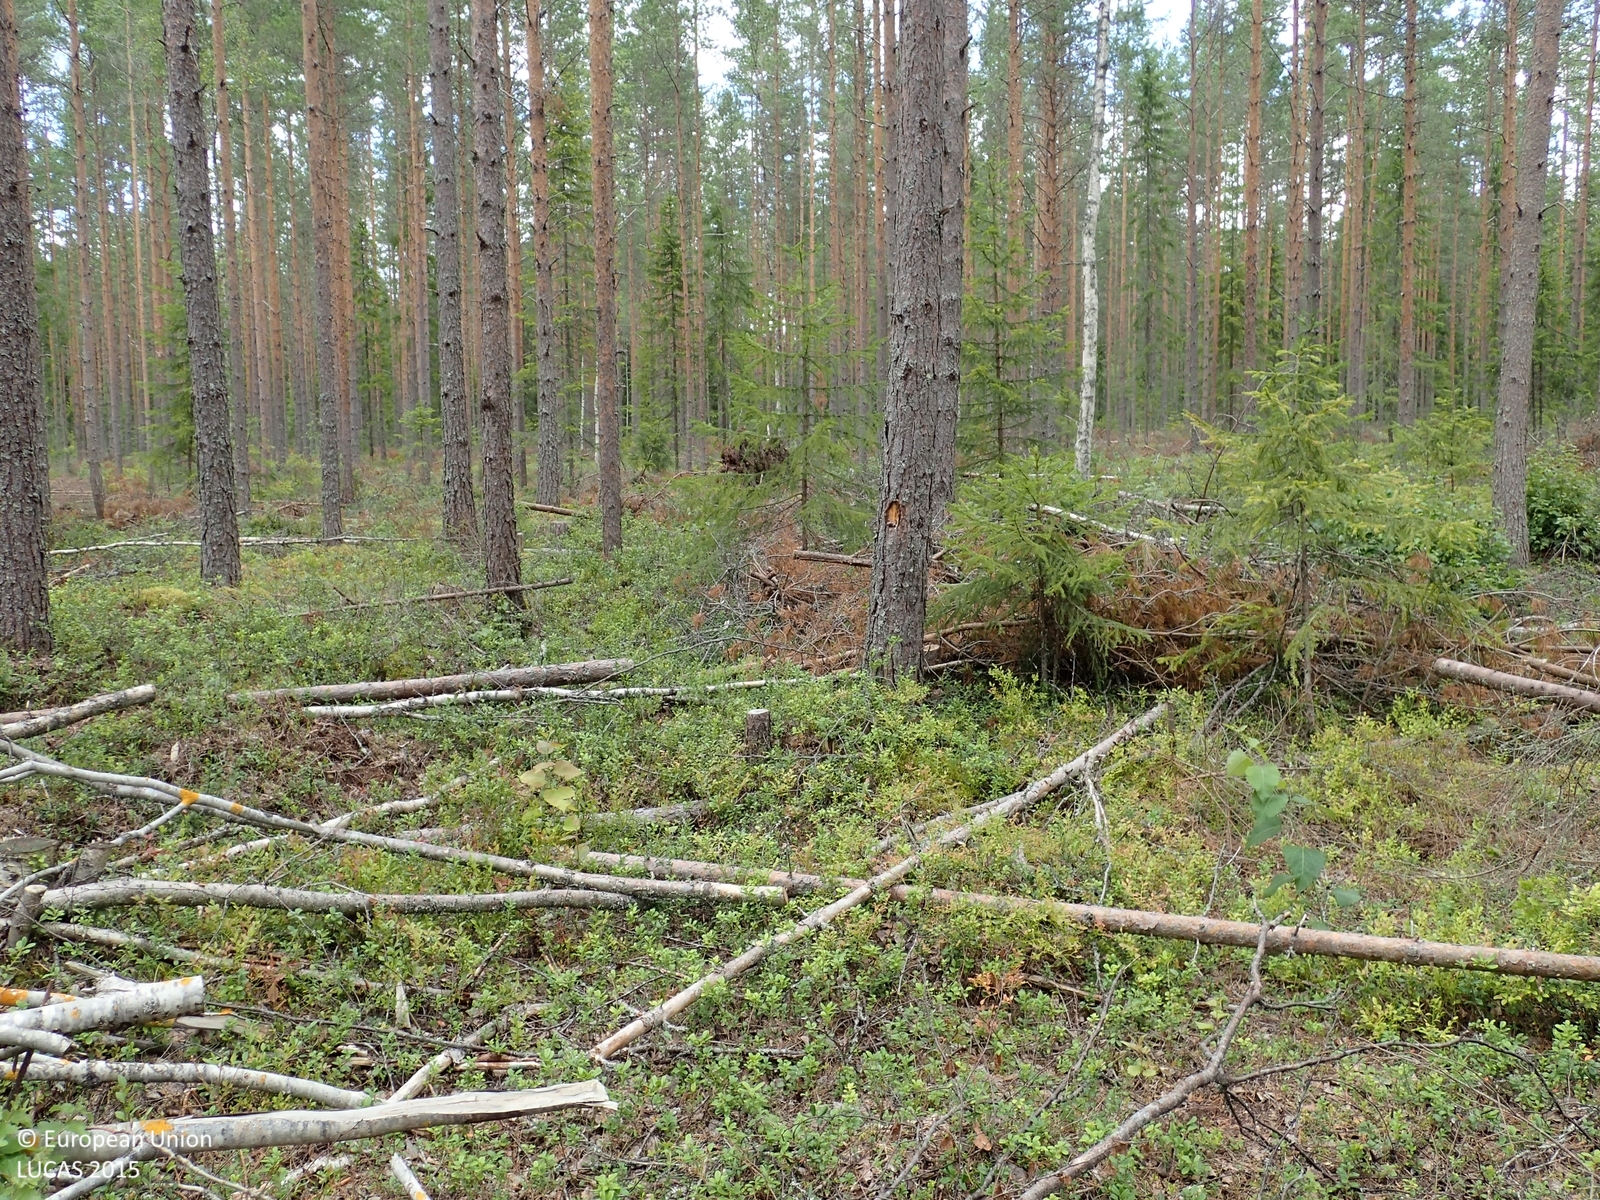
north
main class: Woodland
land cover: Pine dominated coniferous woodland
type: boreal forest
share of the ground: 25 - 50 %
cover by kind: coniferous forest trees 40 %, shrubs 40 %, lichens and mosses 5 %
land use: Forestry
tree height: > 5 m
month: August
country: FI
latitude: 62.6779
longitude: 21.7821
